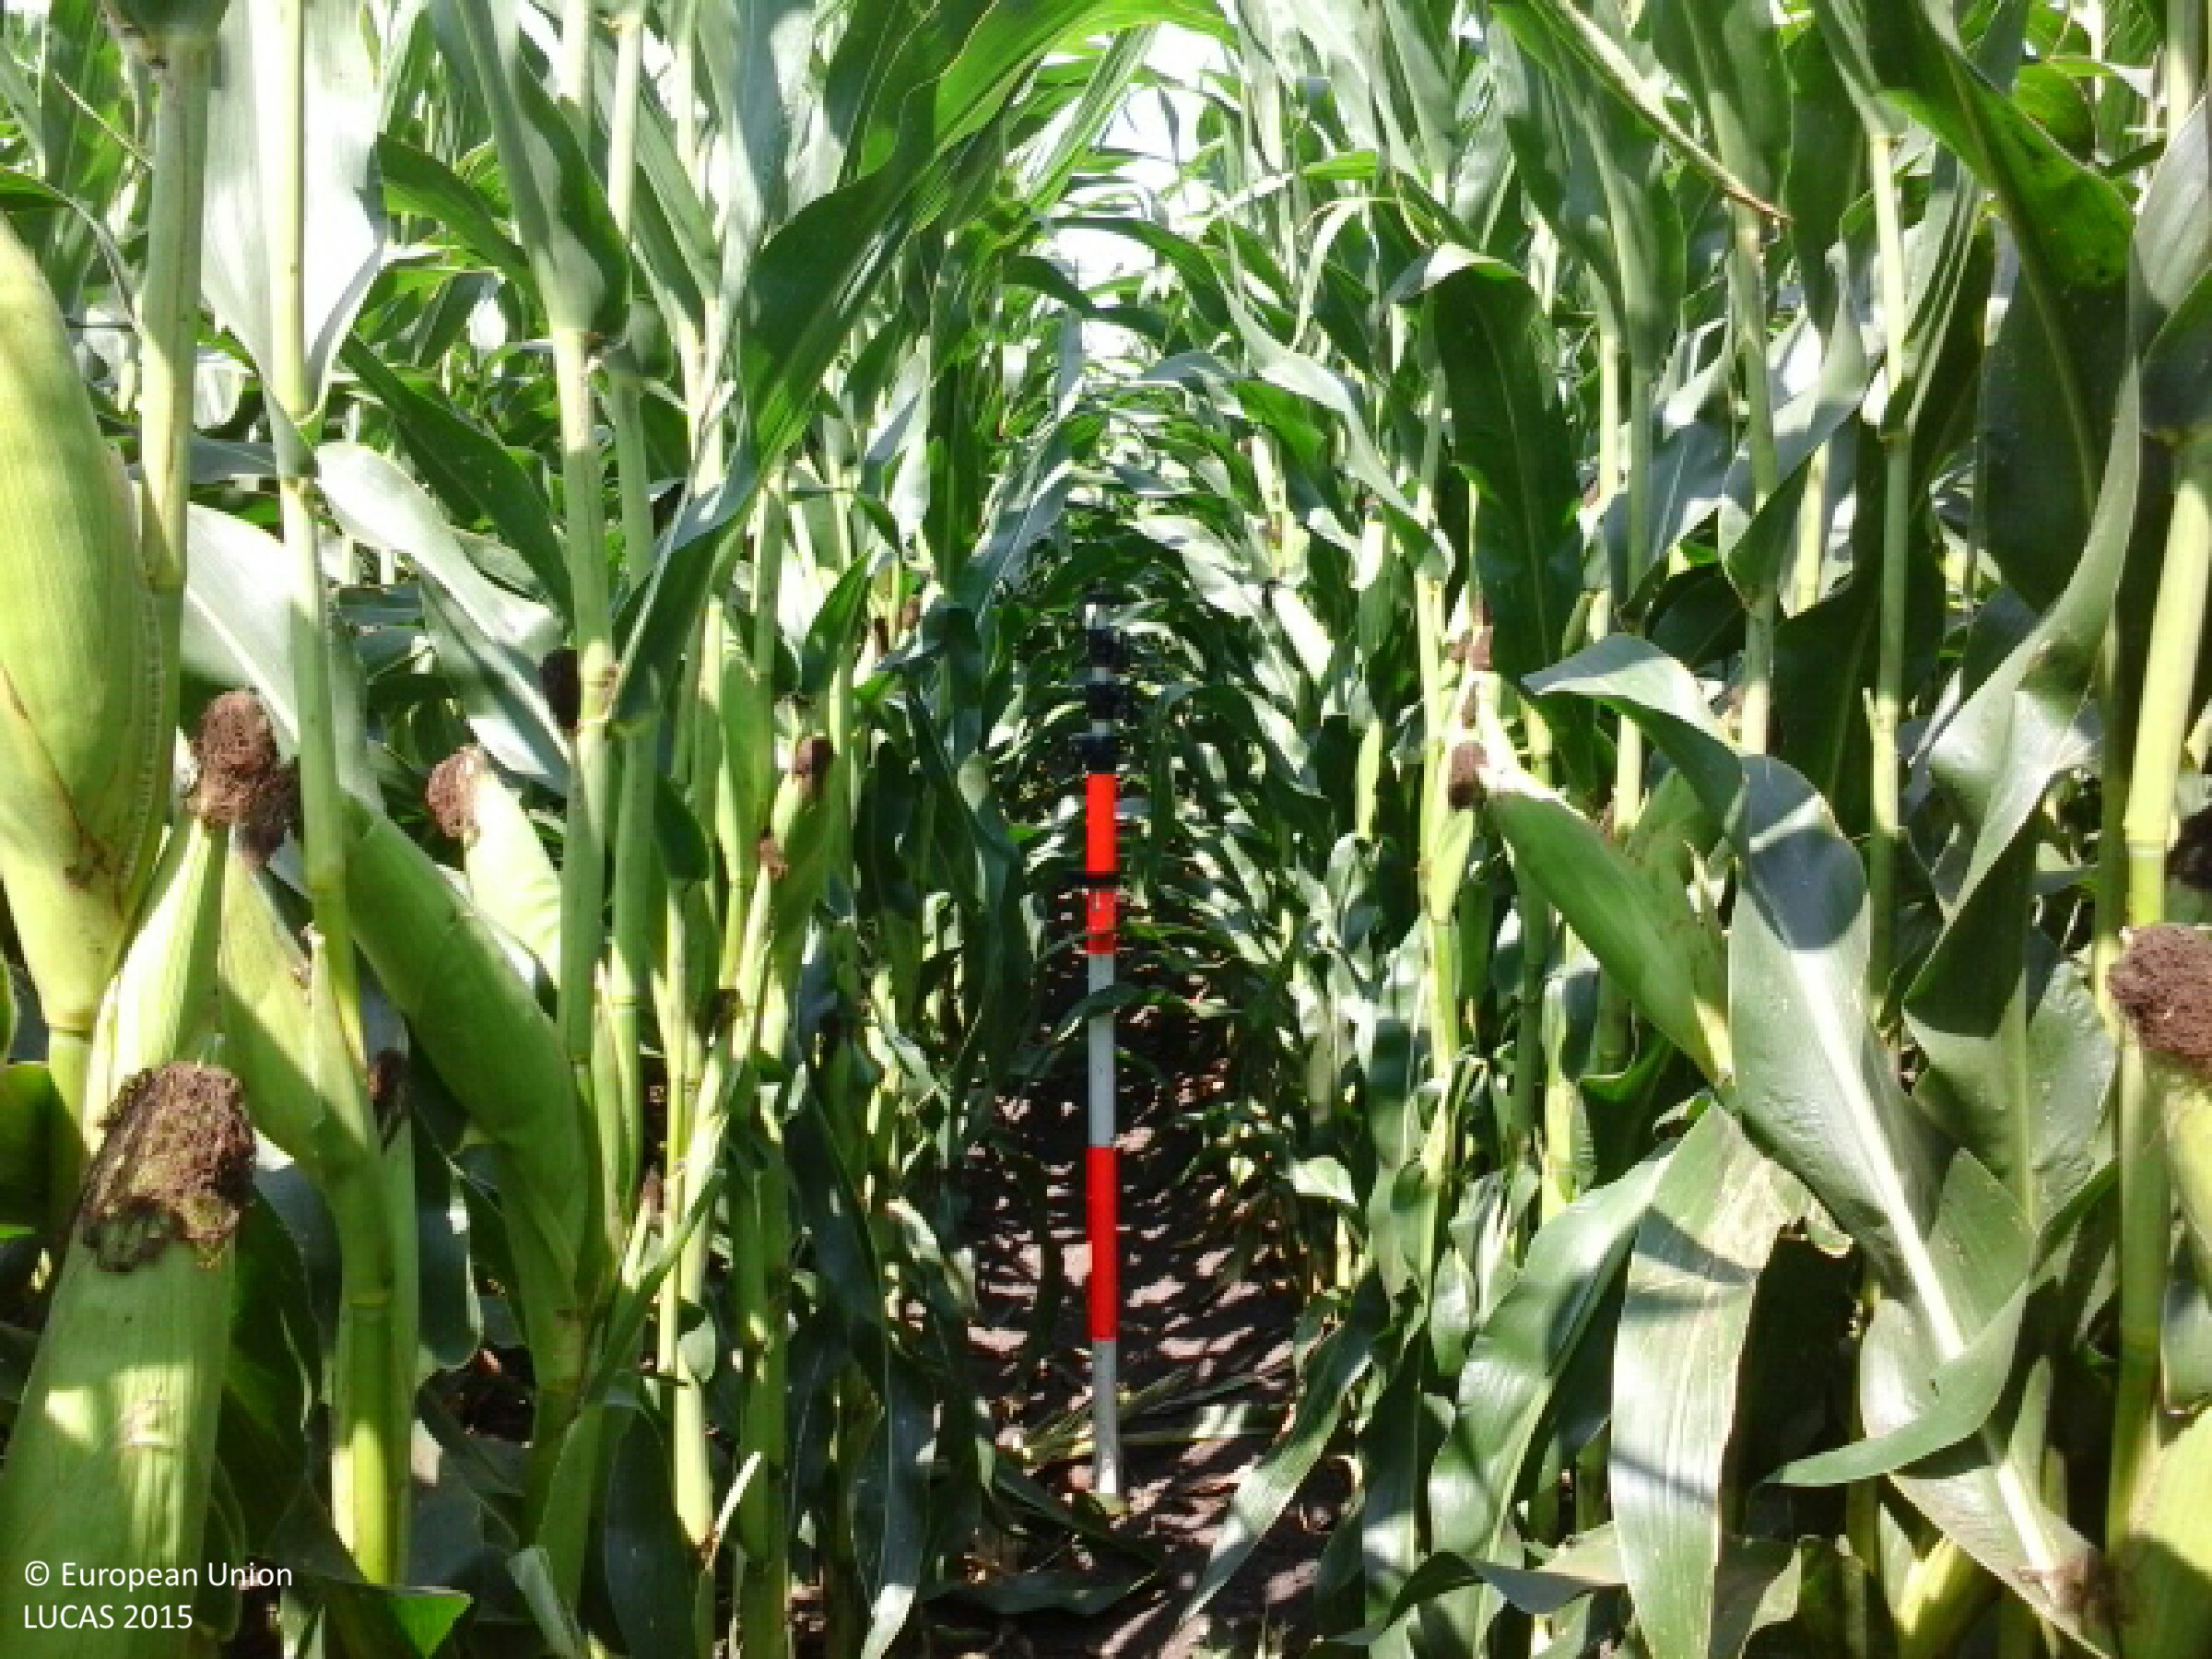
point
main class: Cropland
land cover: Maize
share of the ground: > 75 %
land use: Agriculture (excluding fallow land and kitchen gardens)
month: August
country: HU
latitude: 47.6325
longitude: 18.1436
